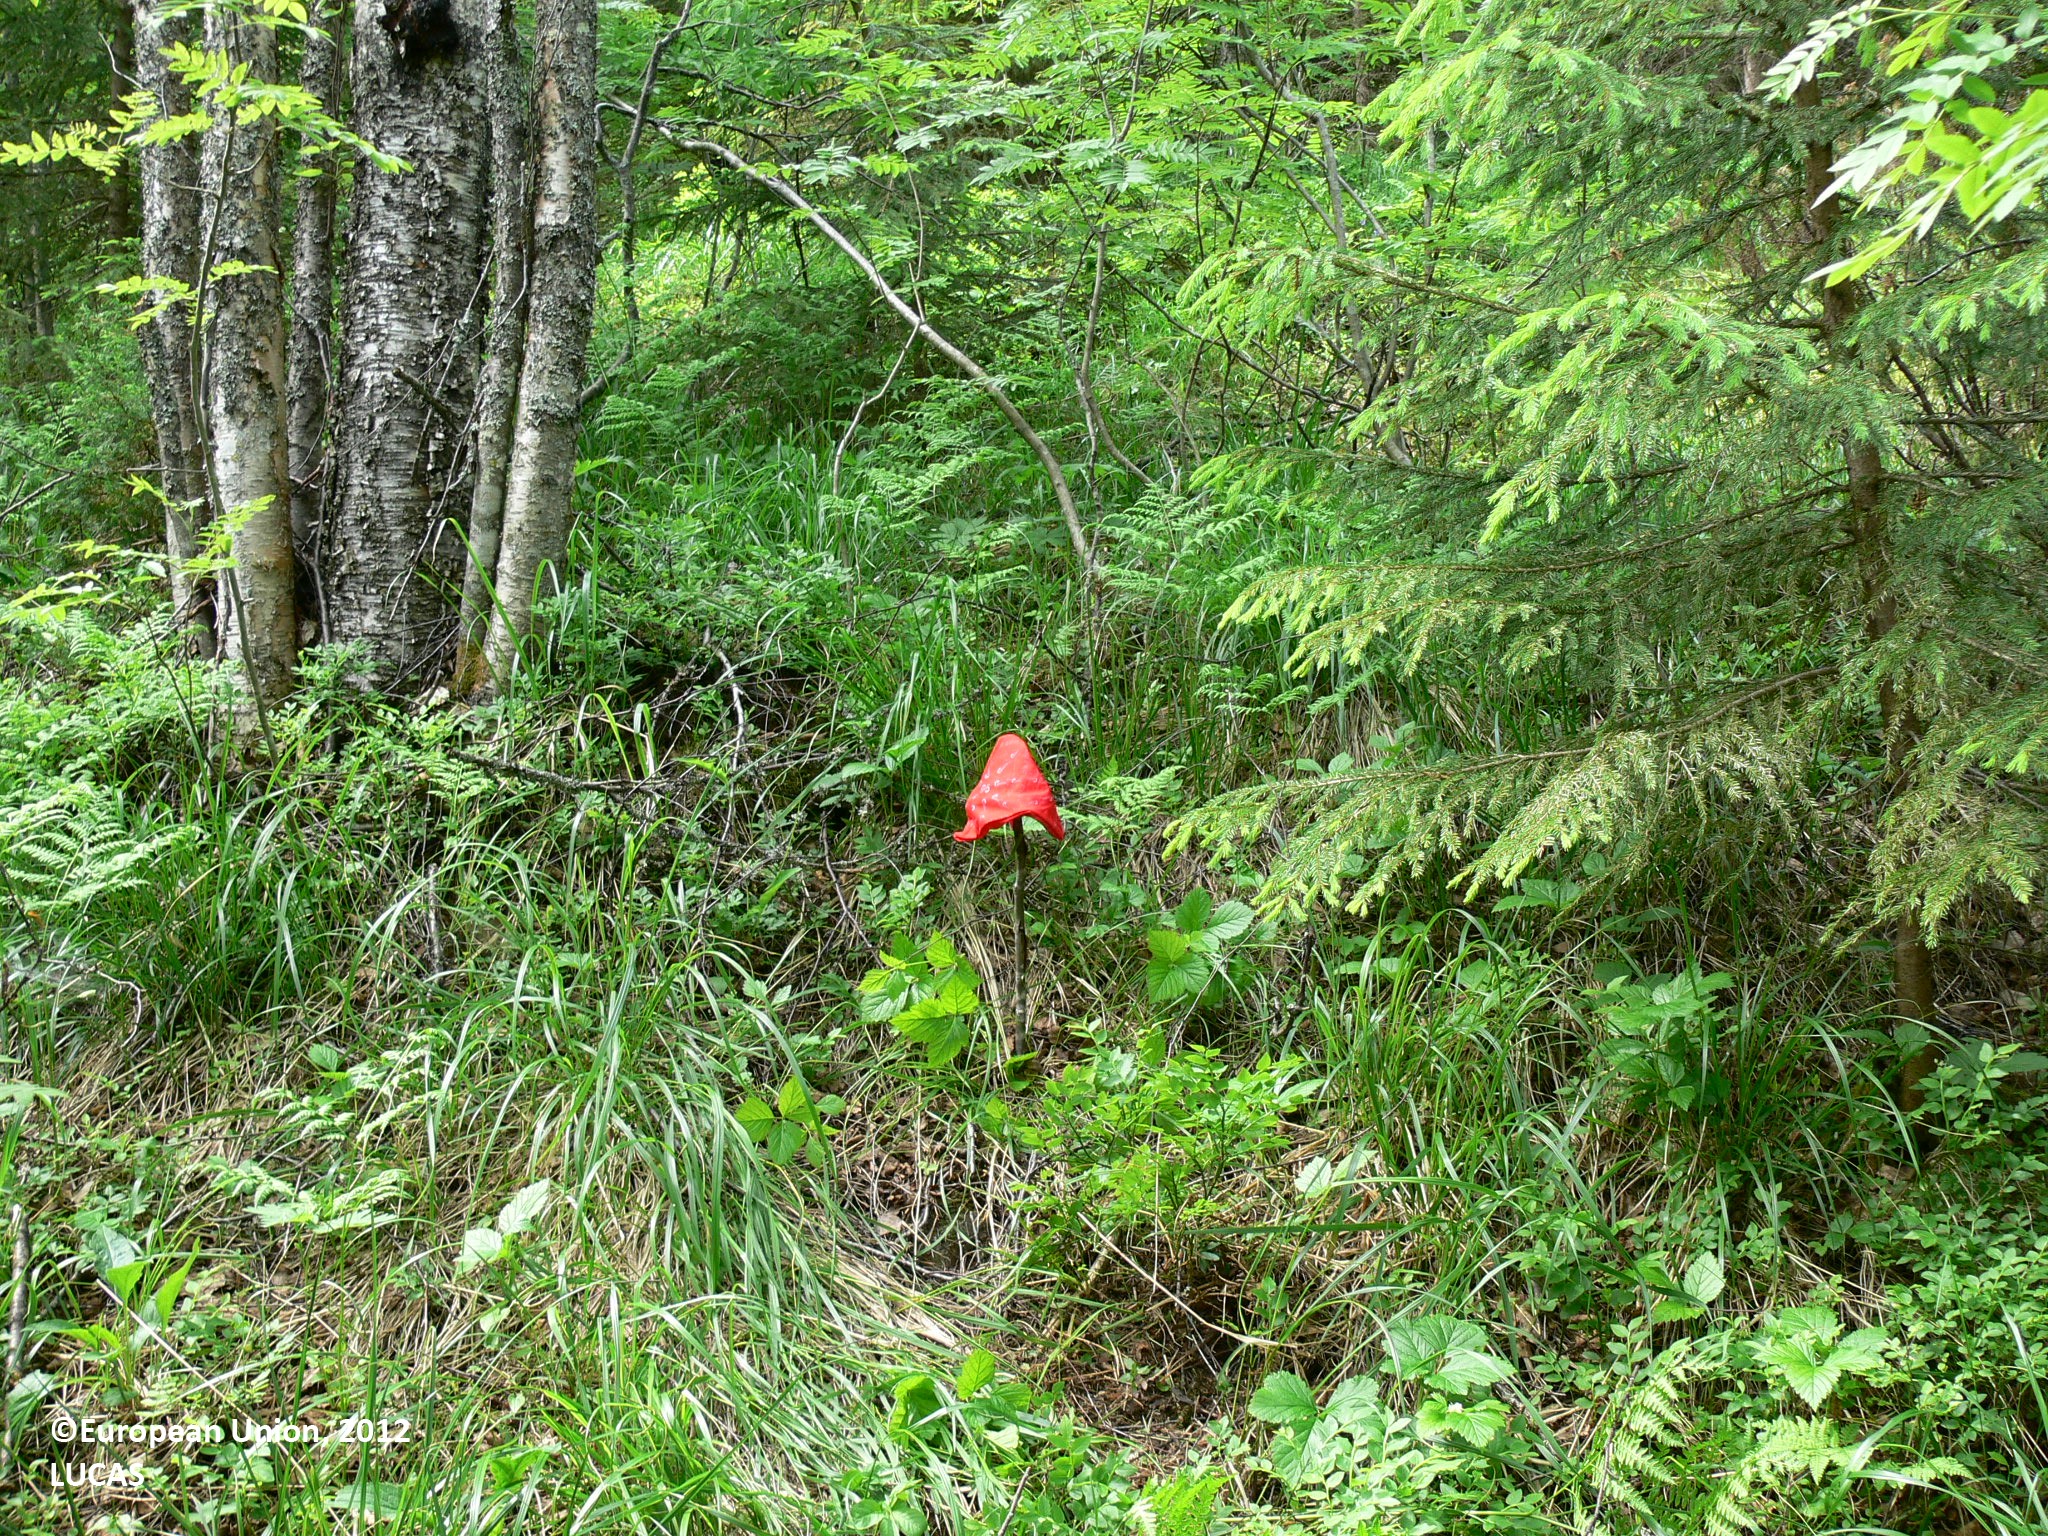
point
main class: Woodland
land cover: Spruce dominated mixed woodland
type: boreal forest
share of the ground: > 75 %
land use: Forestry
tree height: > 5 m
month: June
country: FI
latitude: 62.8229
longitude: 29.9787
